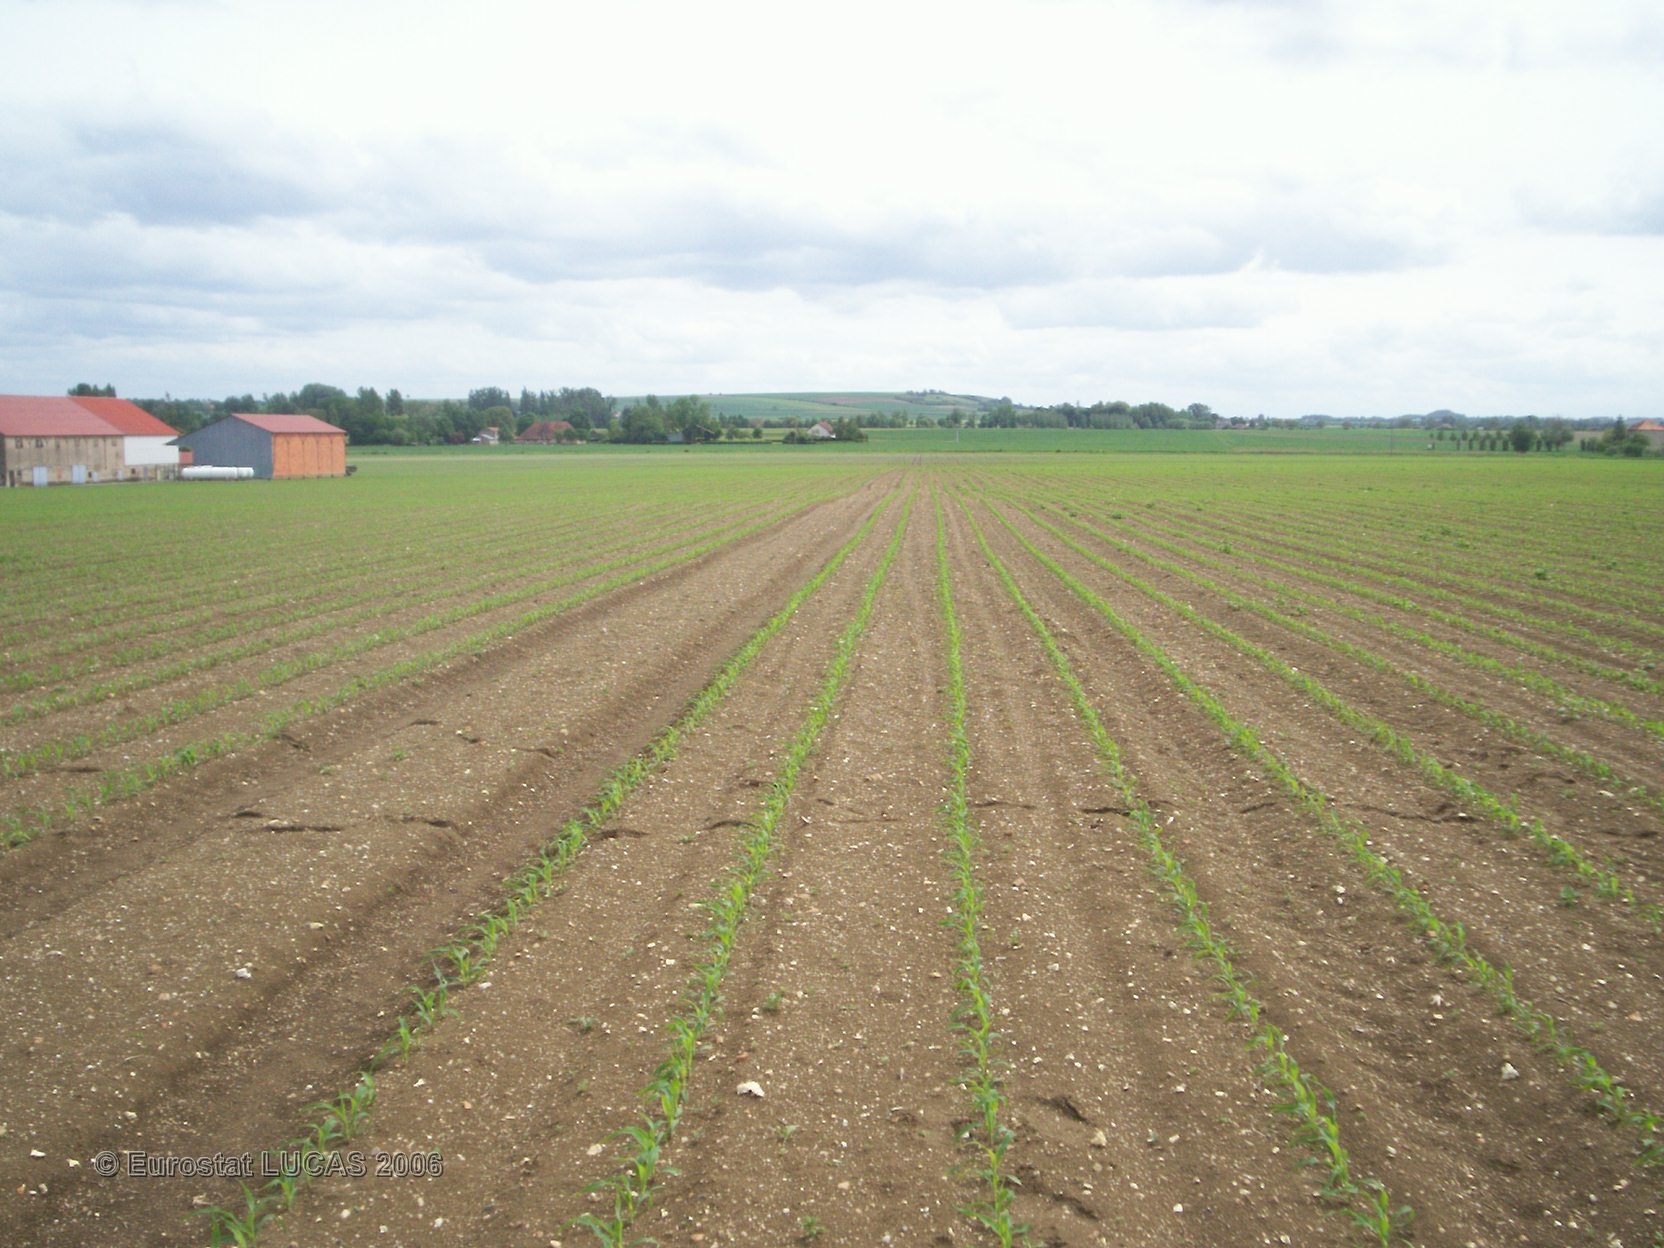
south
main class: Cropland
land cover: Maize
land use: Agriculture (excluding fallow land and kitchen gardens)
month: May
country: FR
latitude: 46.1007
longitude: 3.2337
